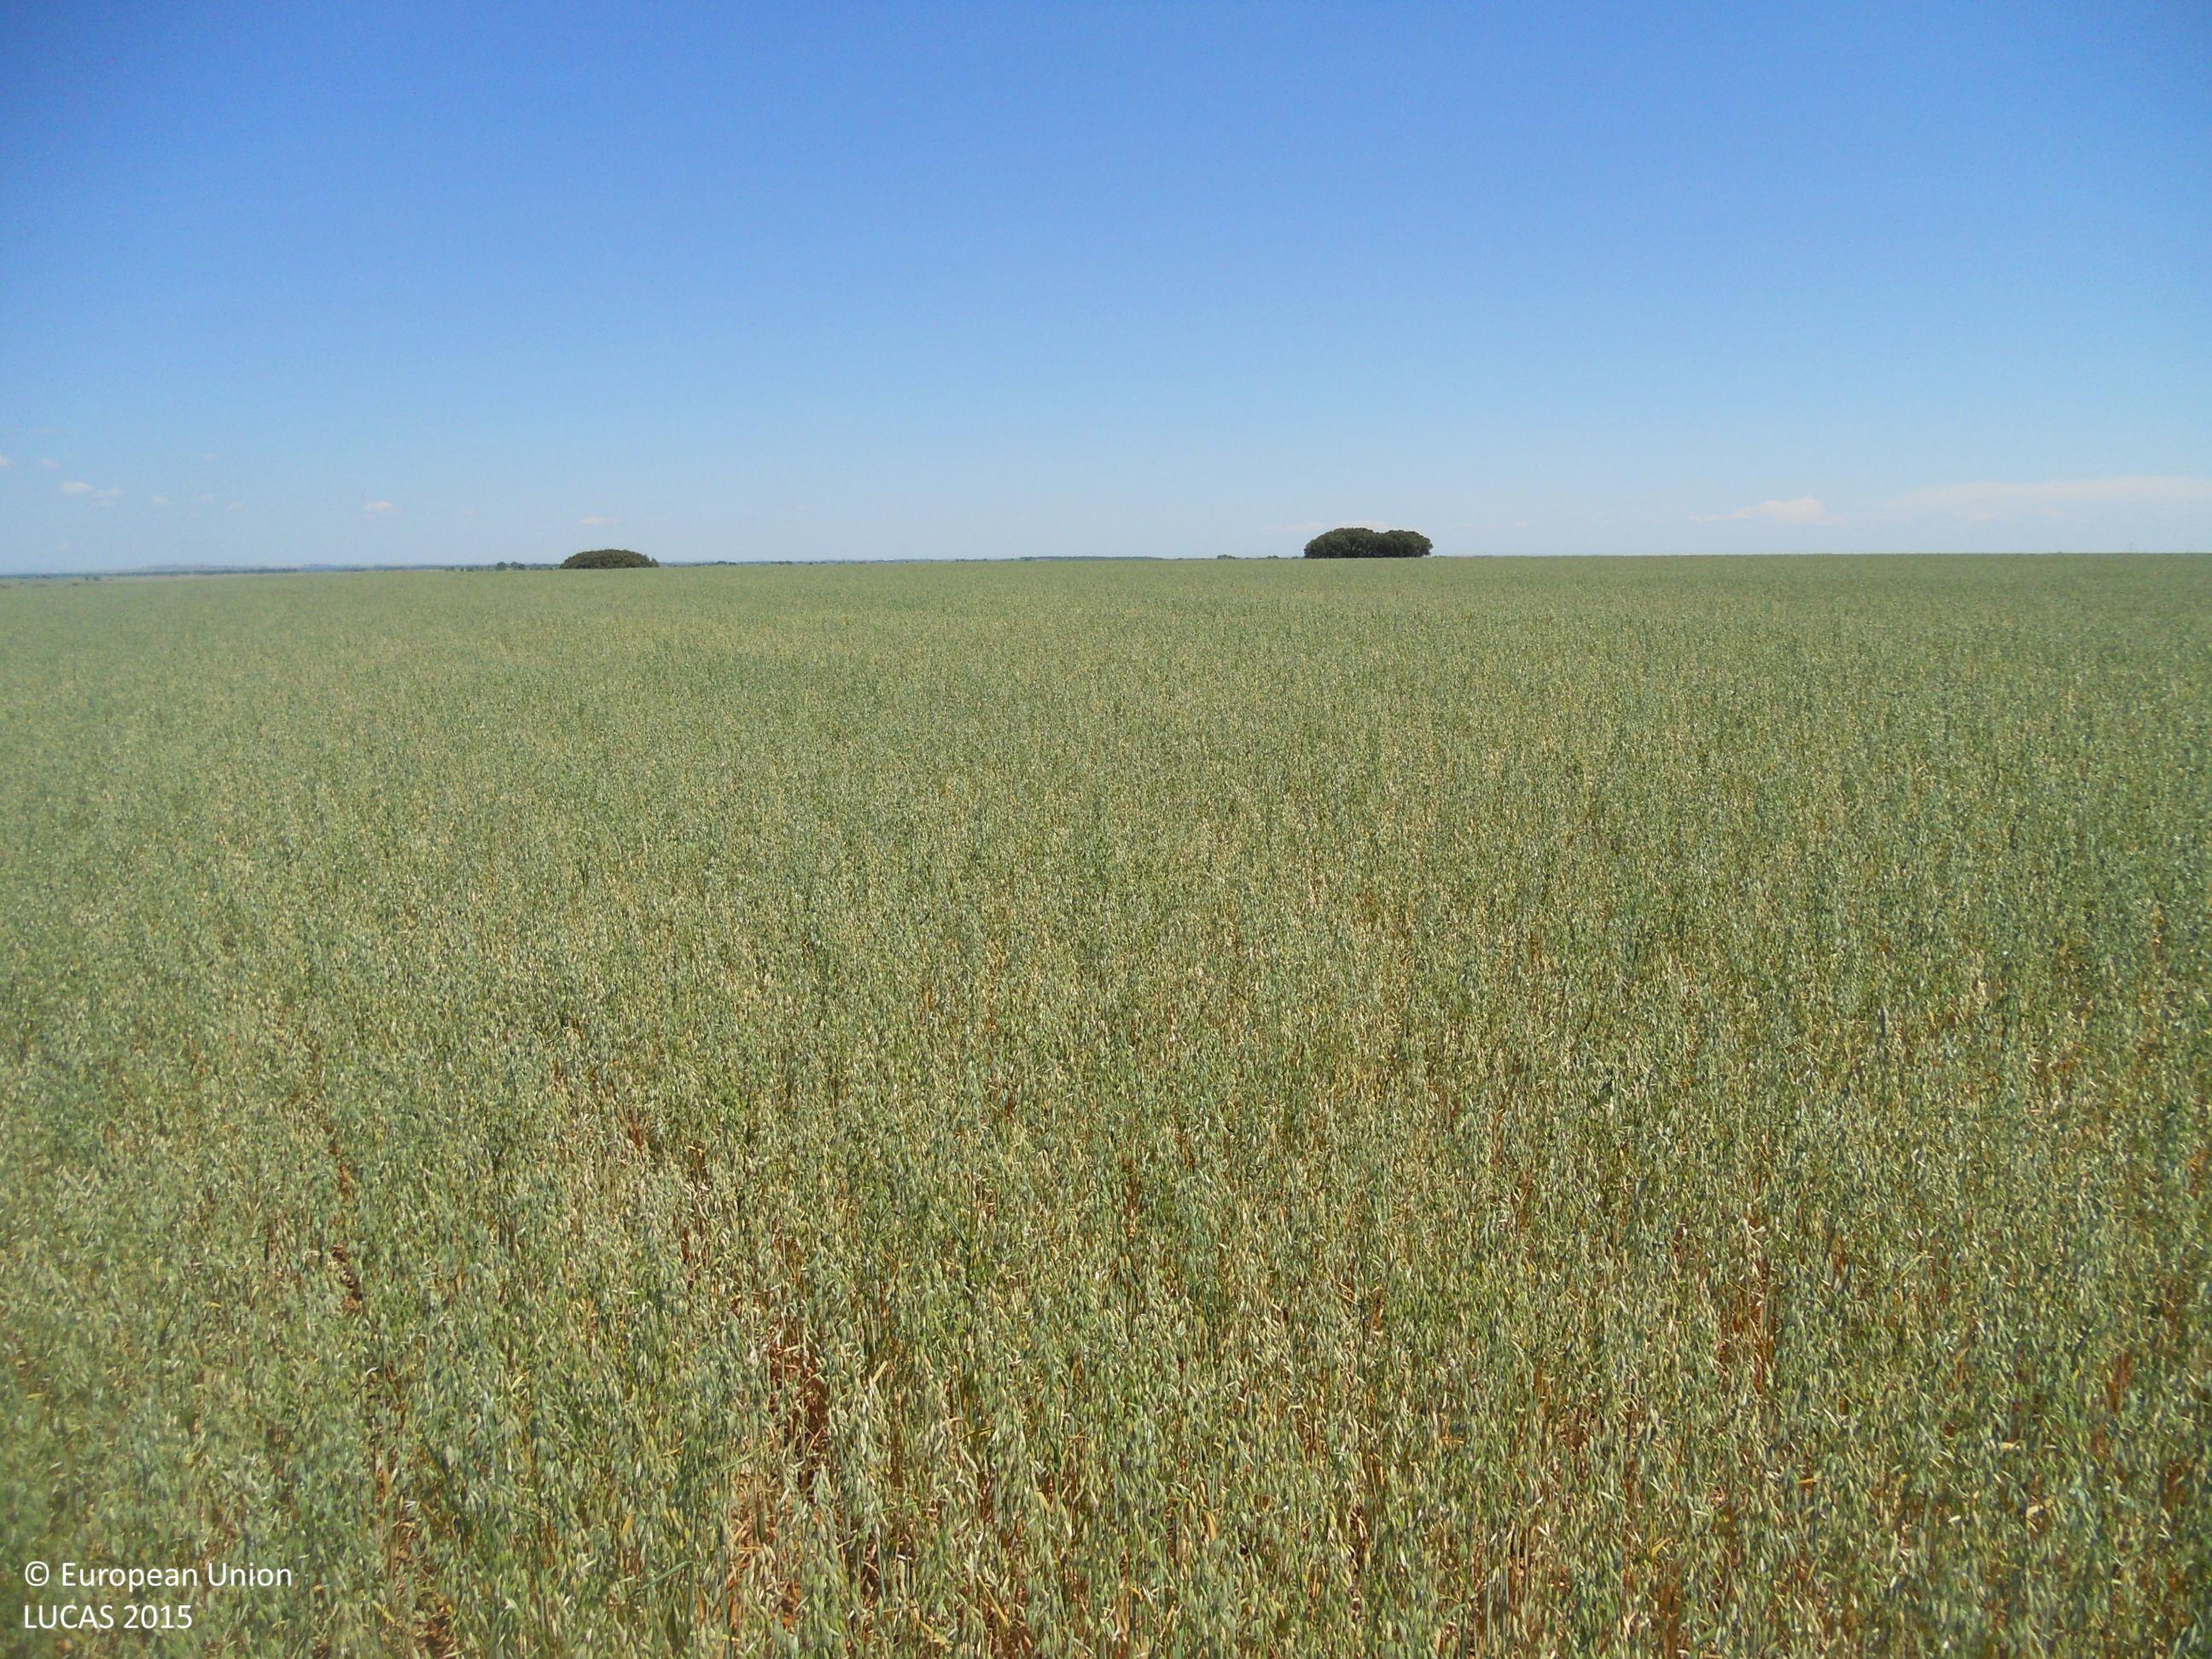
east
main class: Cropland
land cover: Oats
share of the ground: > 75 %
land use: Agriculture (excluding fallow land and kitchen gardens)
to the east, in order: Oats; Grass margins; Oats; Grassland without tree/shrub cover; Shrubland without tree cover
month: May
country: ES
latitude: 42.3086
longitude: -4.8187
